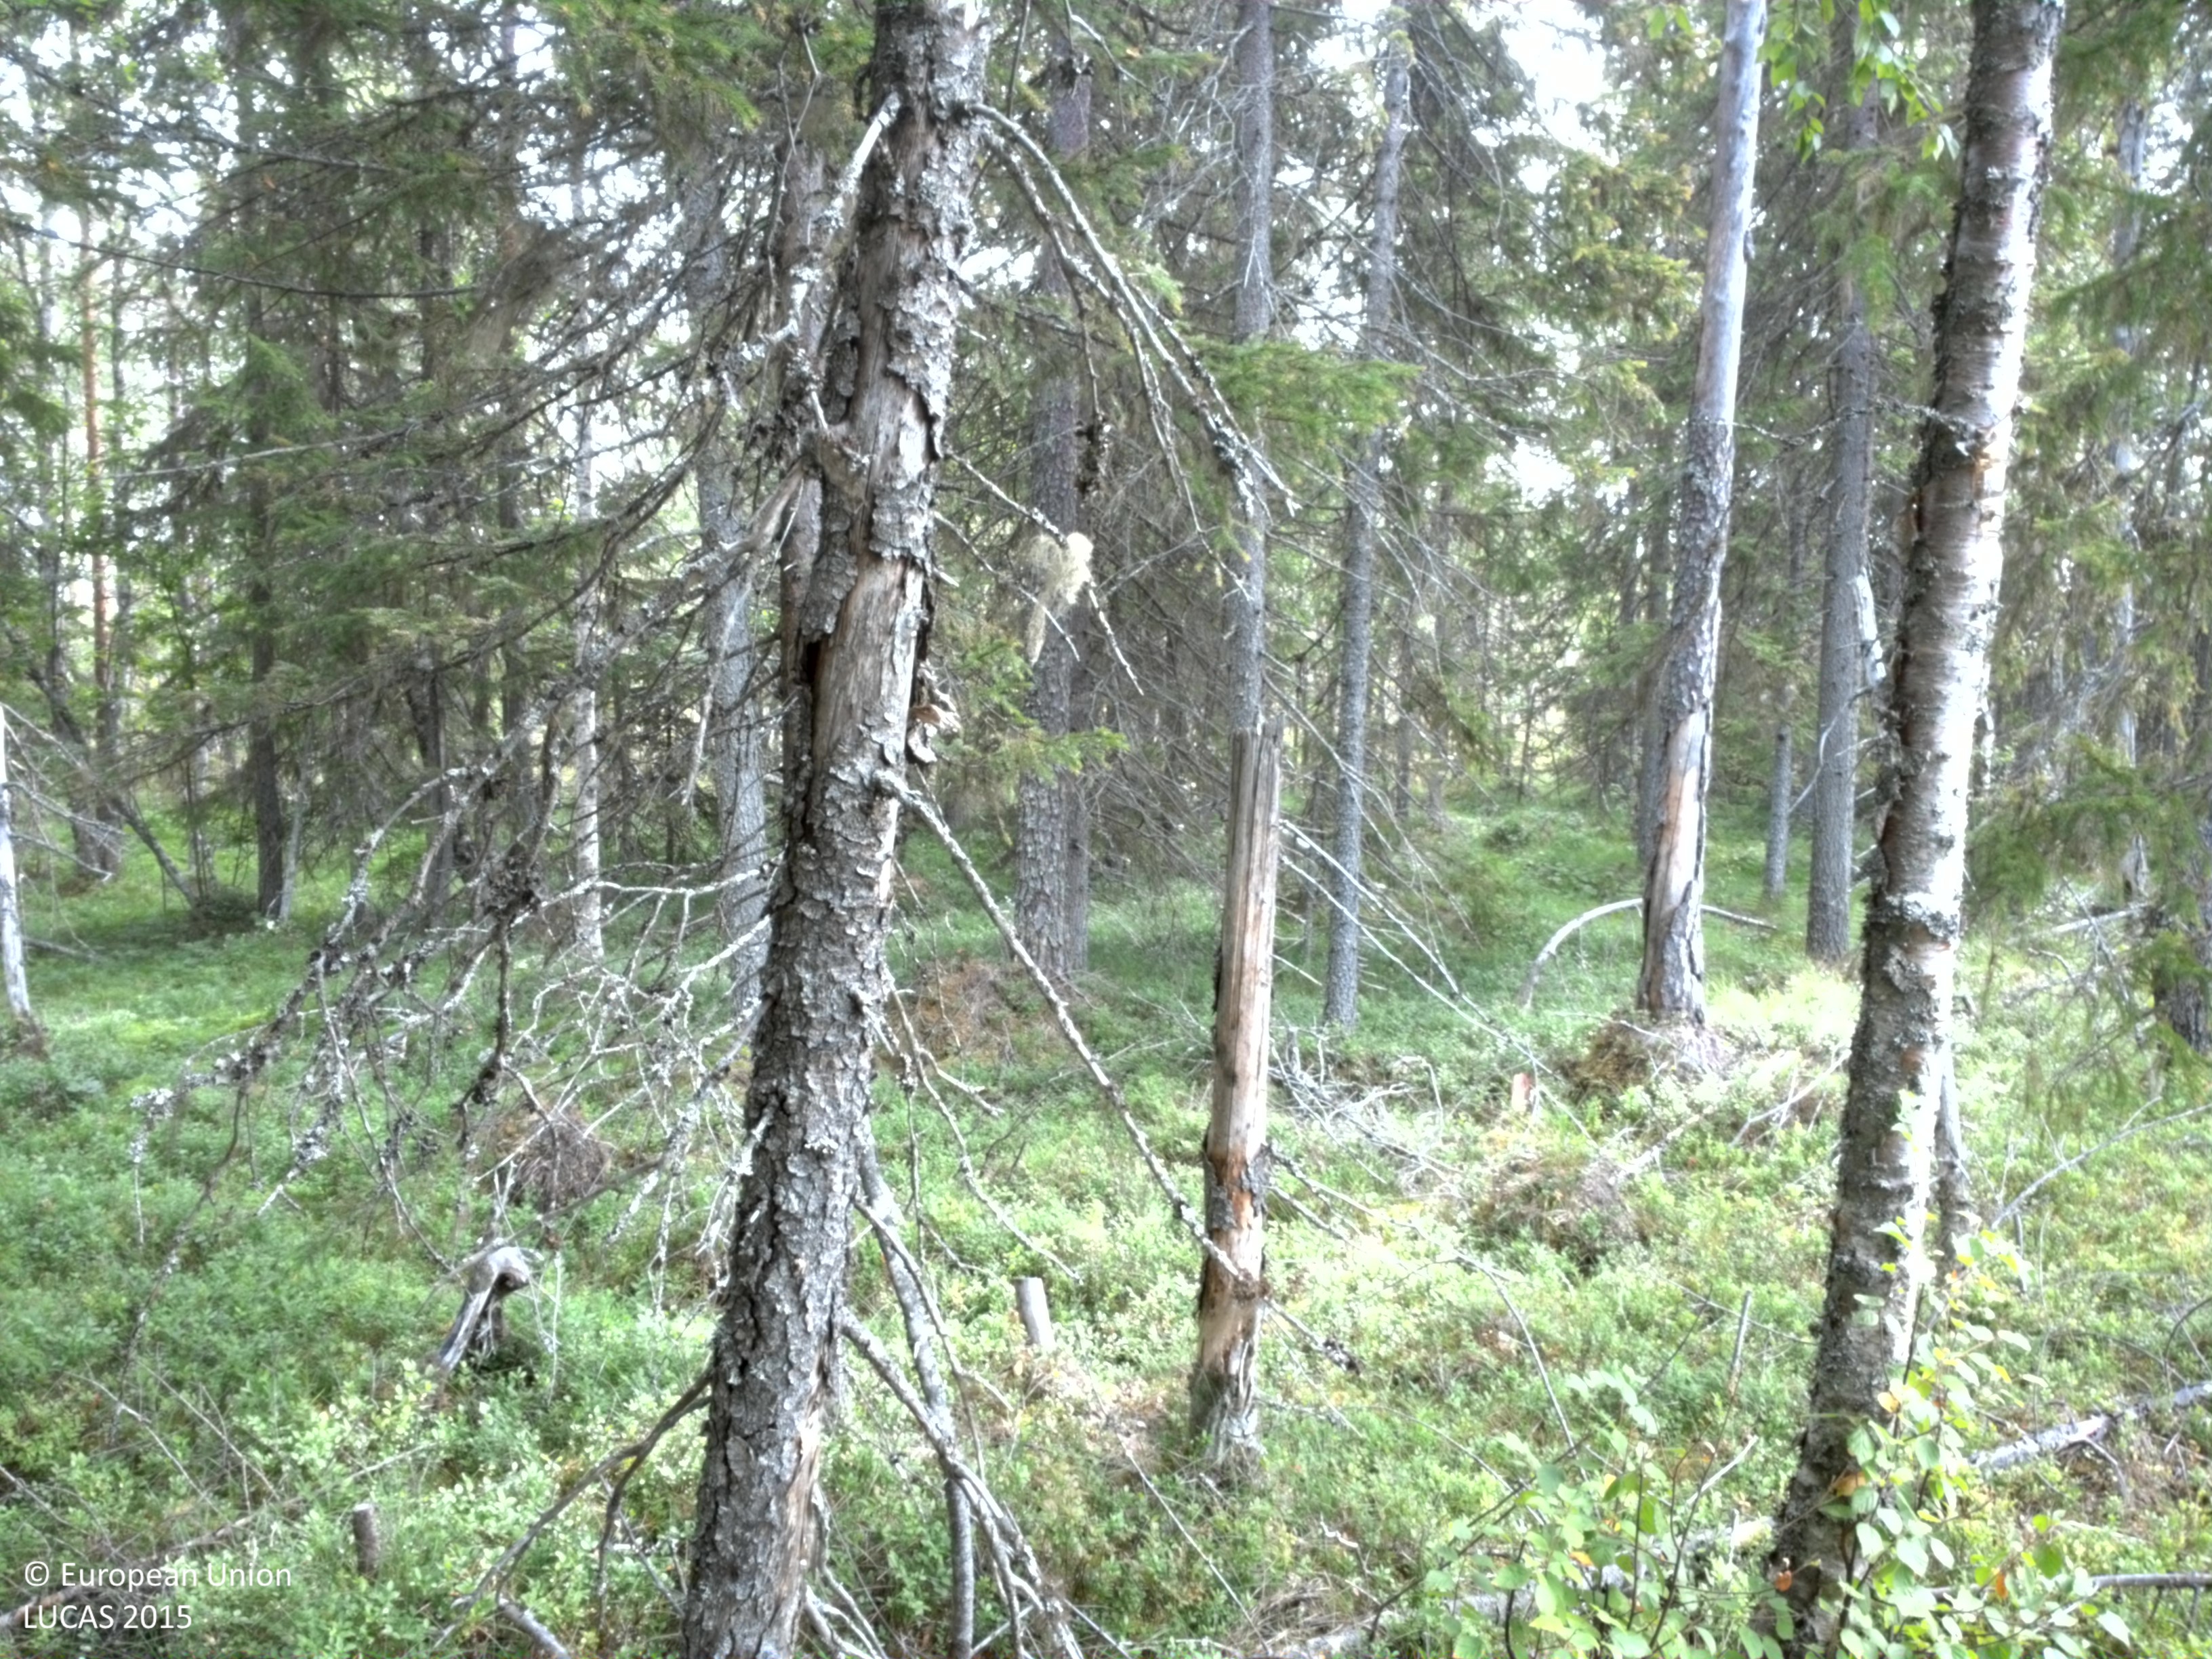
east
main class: Woodland
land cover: Spruce dominated coniferous woodland
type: boreal forest
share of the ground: > 75 %
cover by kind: coniferous forest trees 70 %, shrubs 20 %, broadleaved forest trees 5 %, herbaceous plants 5 %
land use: Forestry
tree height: > 5 m
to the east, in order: Spruce dominated coniferous woodland; Other coniferous woodland; Pine dominated coniferous woodland; Peatbogs
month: August
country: SE
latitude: 64.5503
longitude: 20.0896
